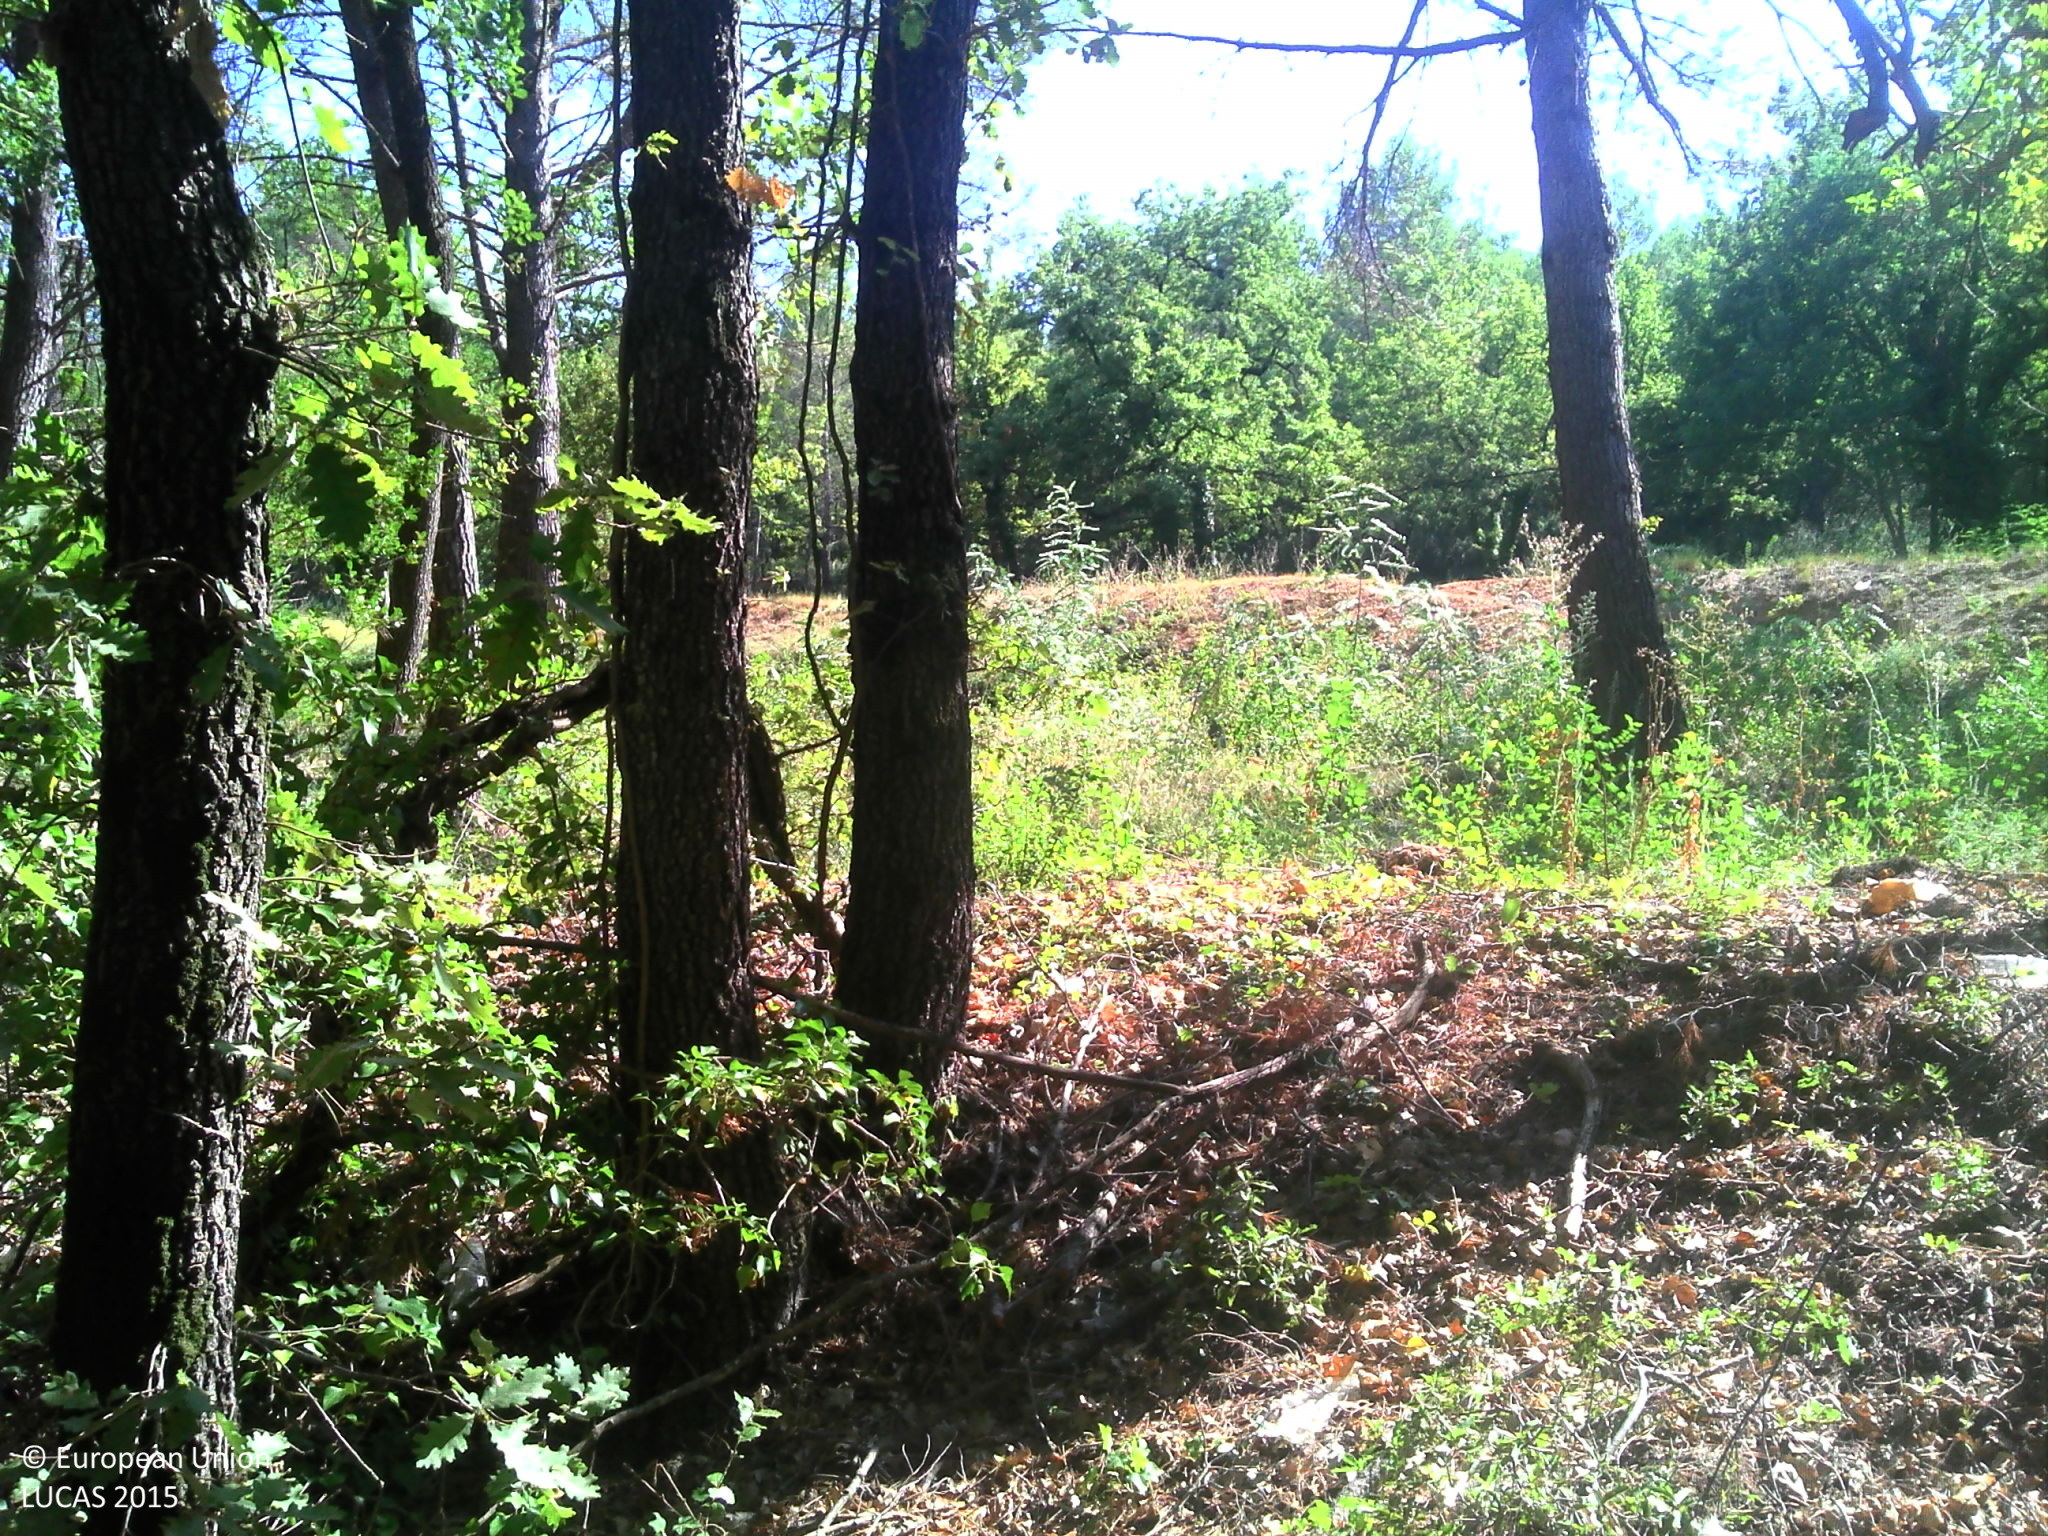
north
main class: Woodland
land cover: Pine dominated mixed woodland
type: coniferous forest of the mediterranean region
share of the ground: > 75 %
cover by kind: coniferous forest trees 50 %, broadleaved forest trees 50 %
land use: Forestry
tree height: > 5 m
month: August
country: FR
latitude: 43.3880
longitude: 5.5535
